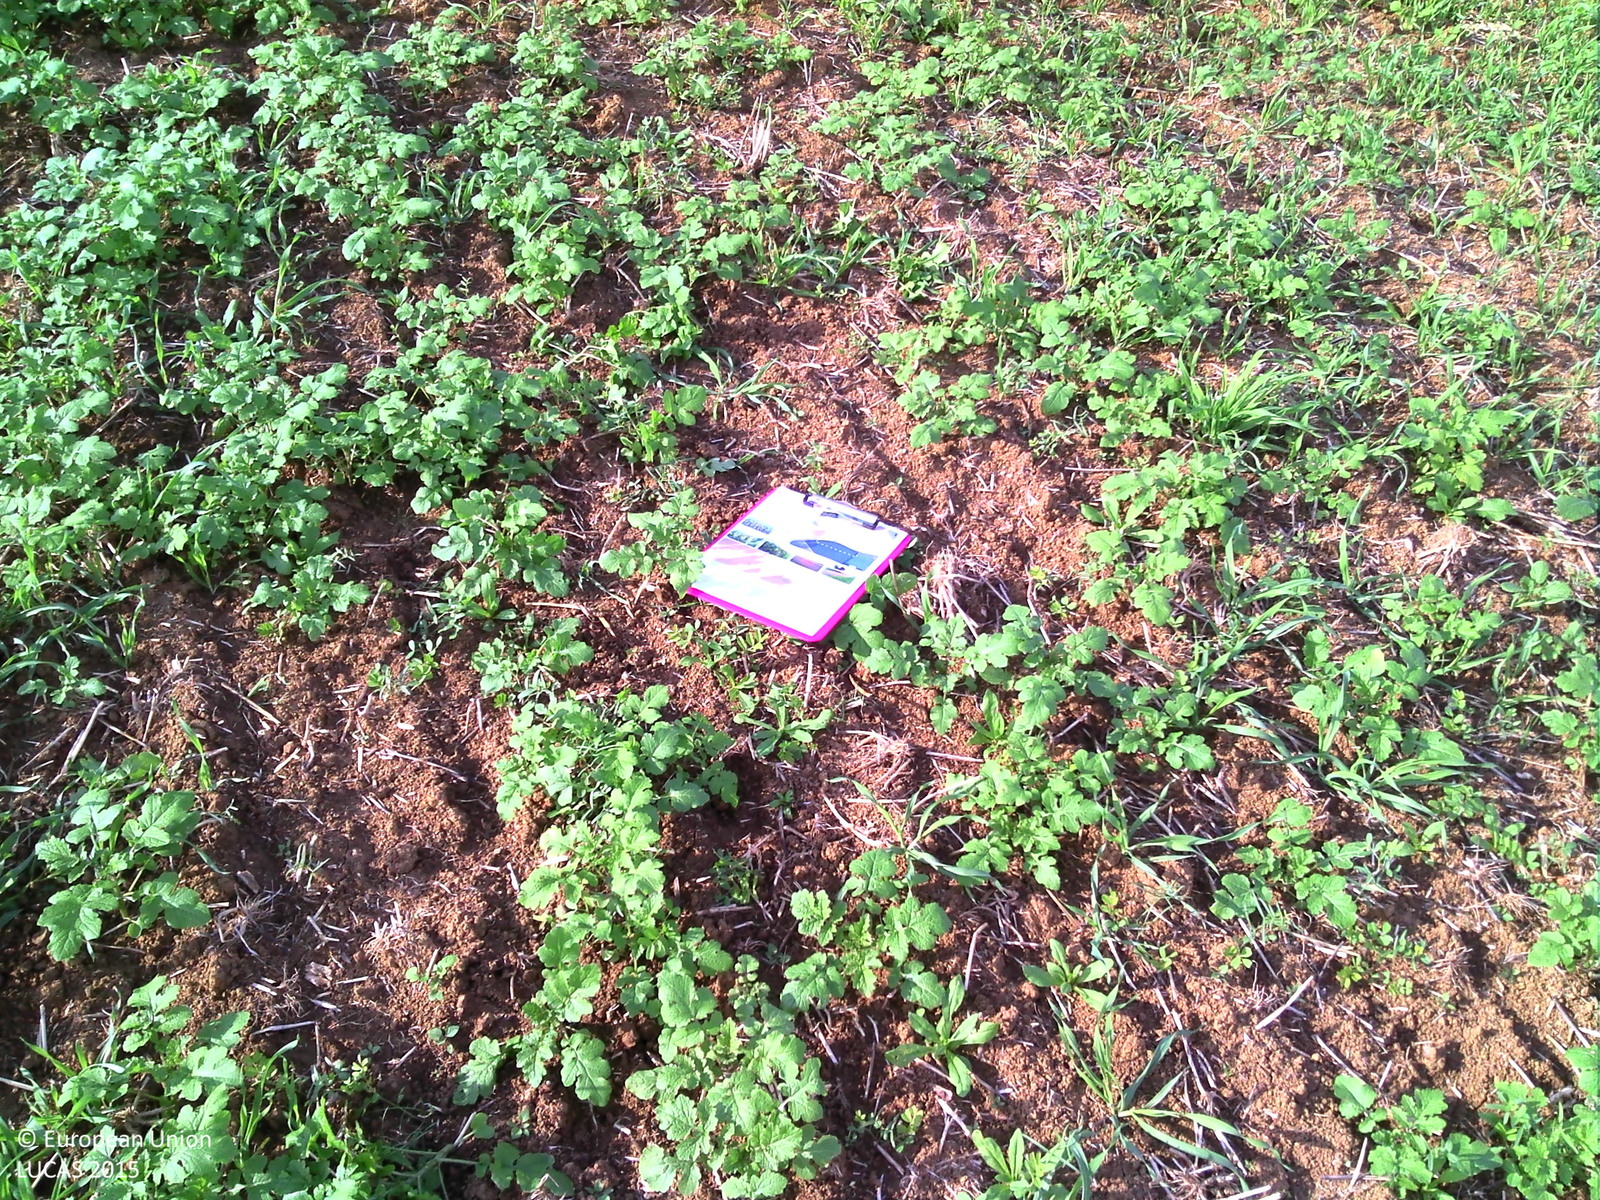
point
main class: Cropland
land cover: Other fibre and oleaginous crops
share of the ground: > 75 %
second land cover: Other leguminous and mixtures for fodder
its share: < 10 %
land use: Agriculture (excluding fallow land and kitchen gardens)
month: September
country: FR
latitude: 48.5238
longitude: 4.5950
